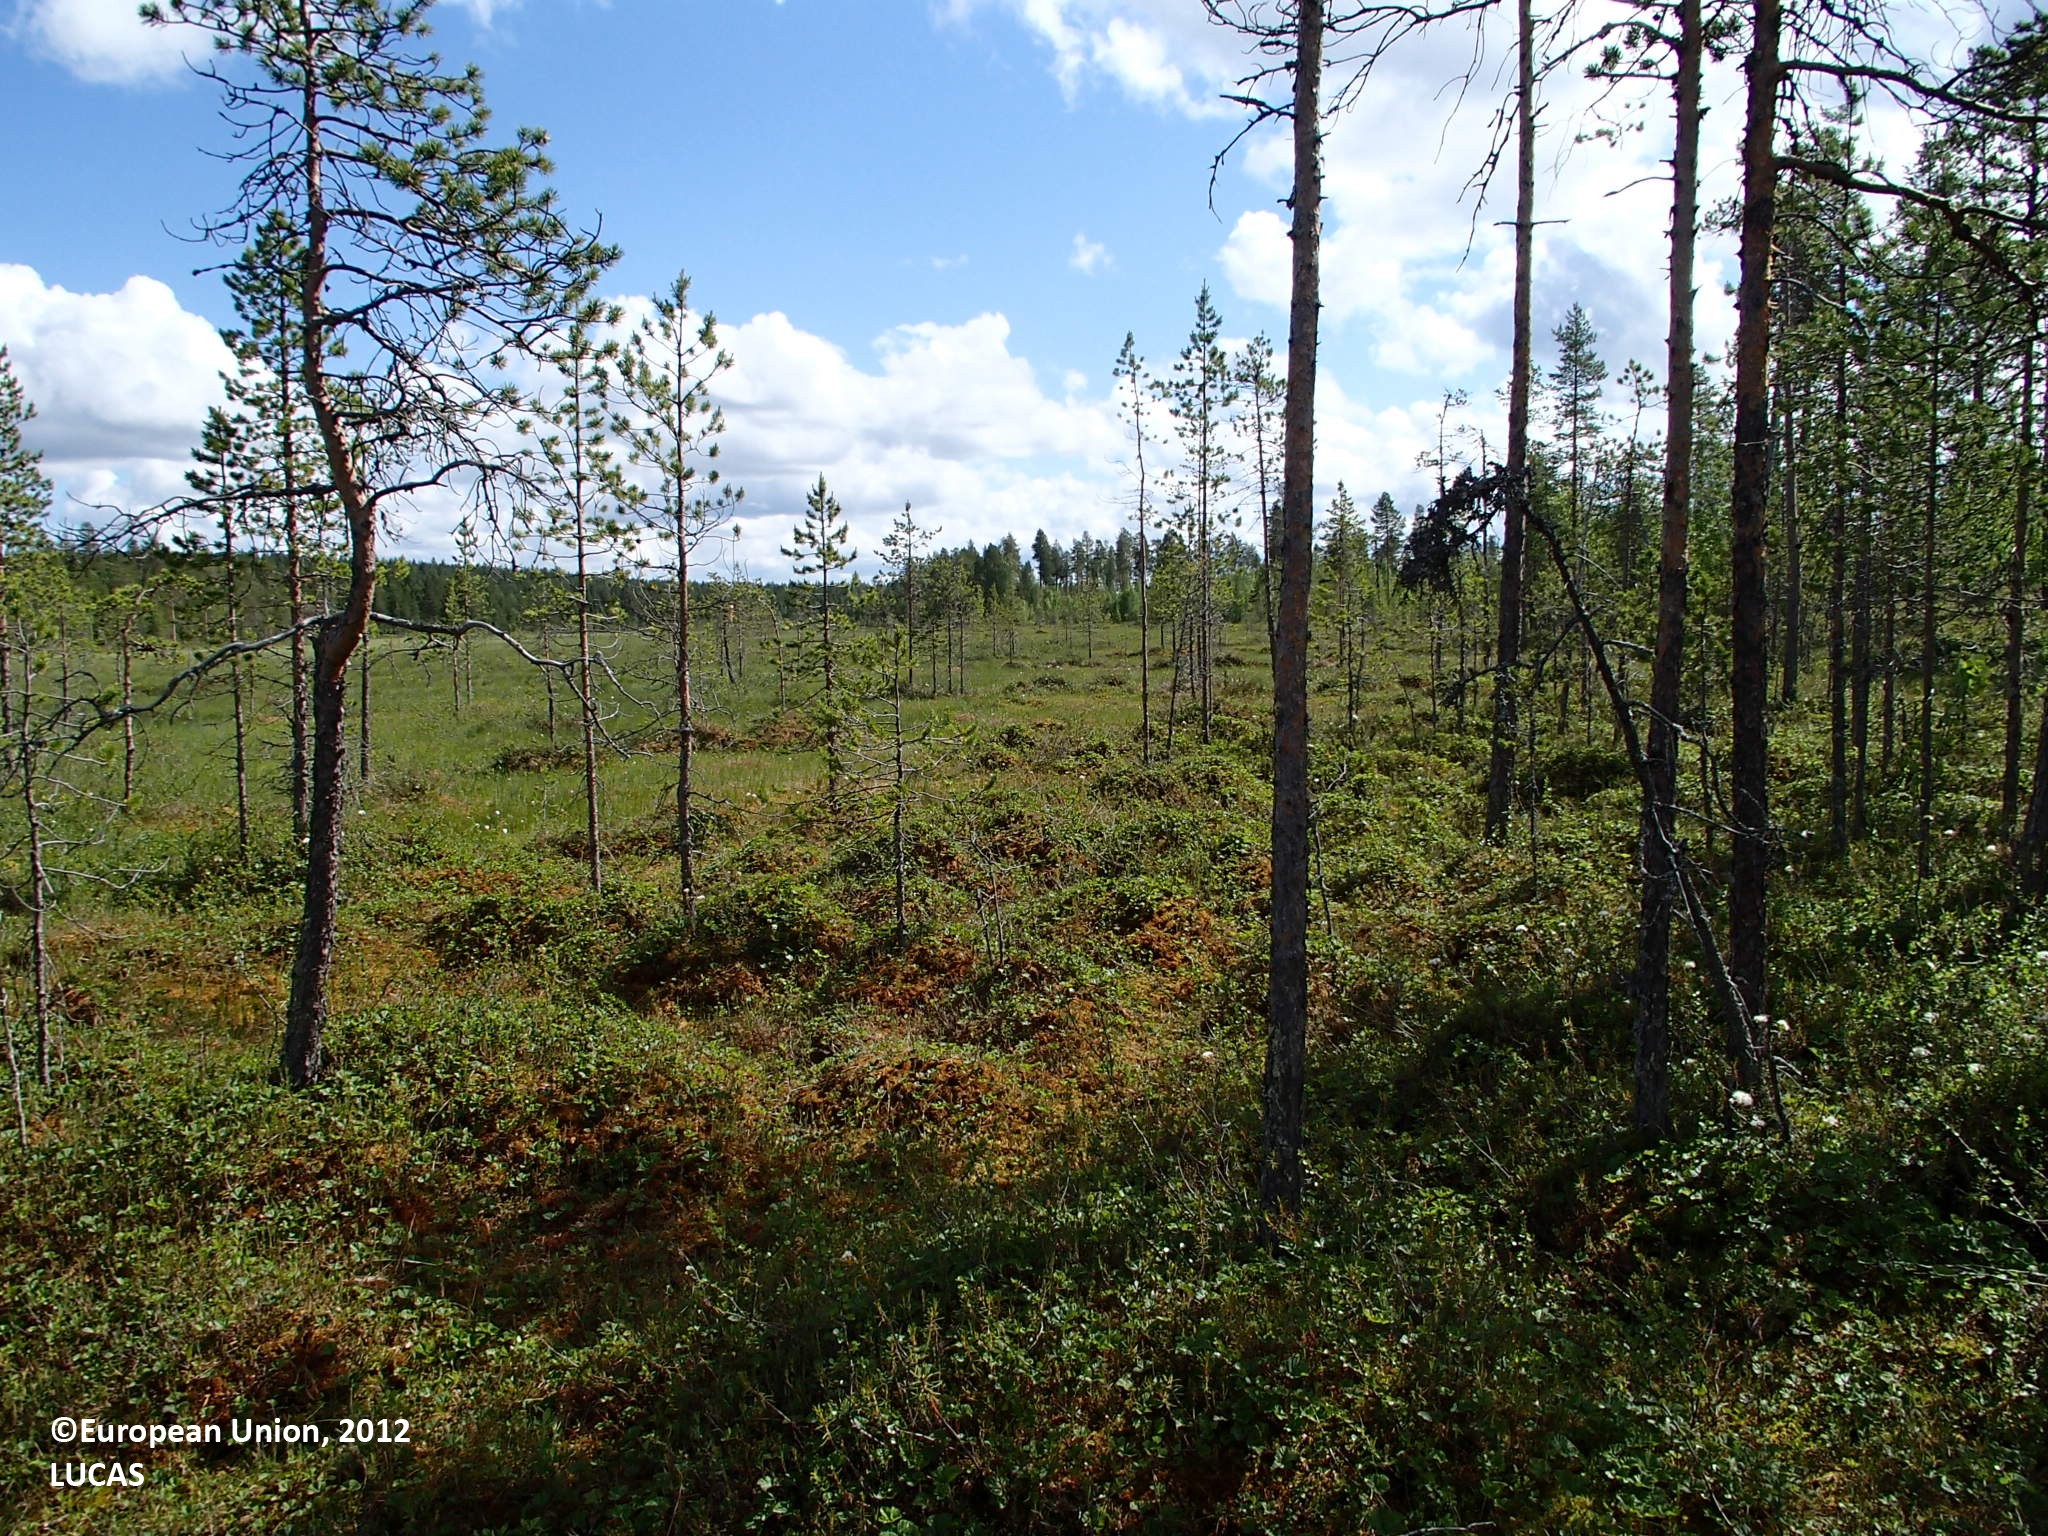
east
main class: Woodland
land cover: Pine dominated coniferous woodland
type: boreal forest
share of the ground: 10 - 25 %
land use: Forestry
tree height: > 5 m
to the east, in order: Pine dominated coniferous woodland; Peatbogs
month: July
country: FI
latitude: 67.3293
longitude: 26.7502
